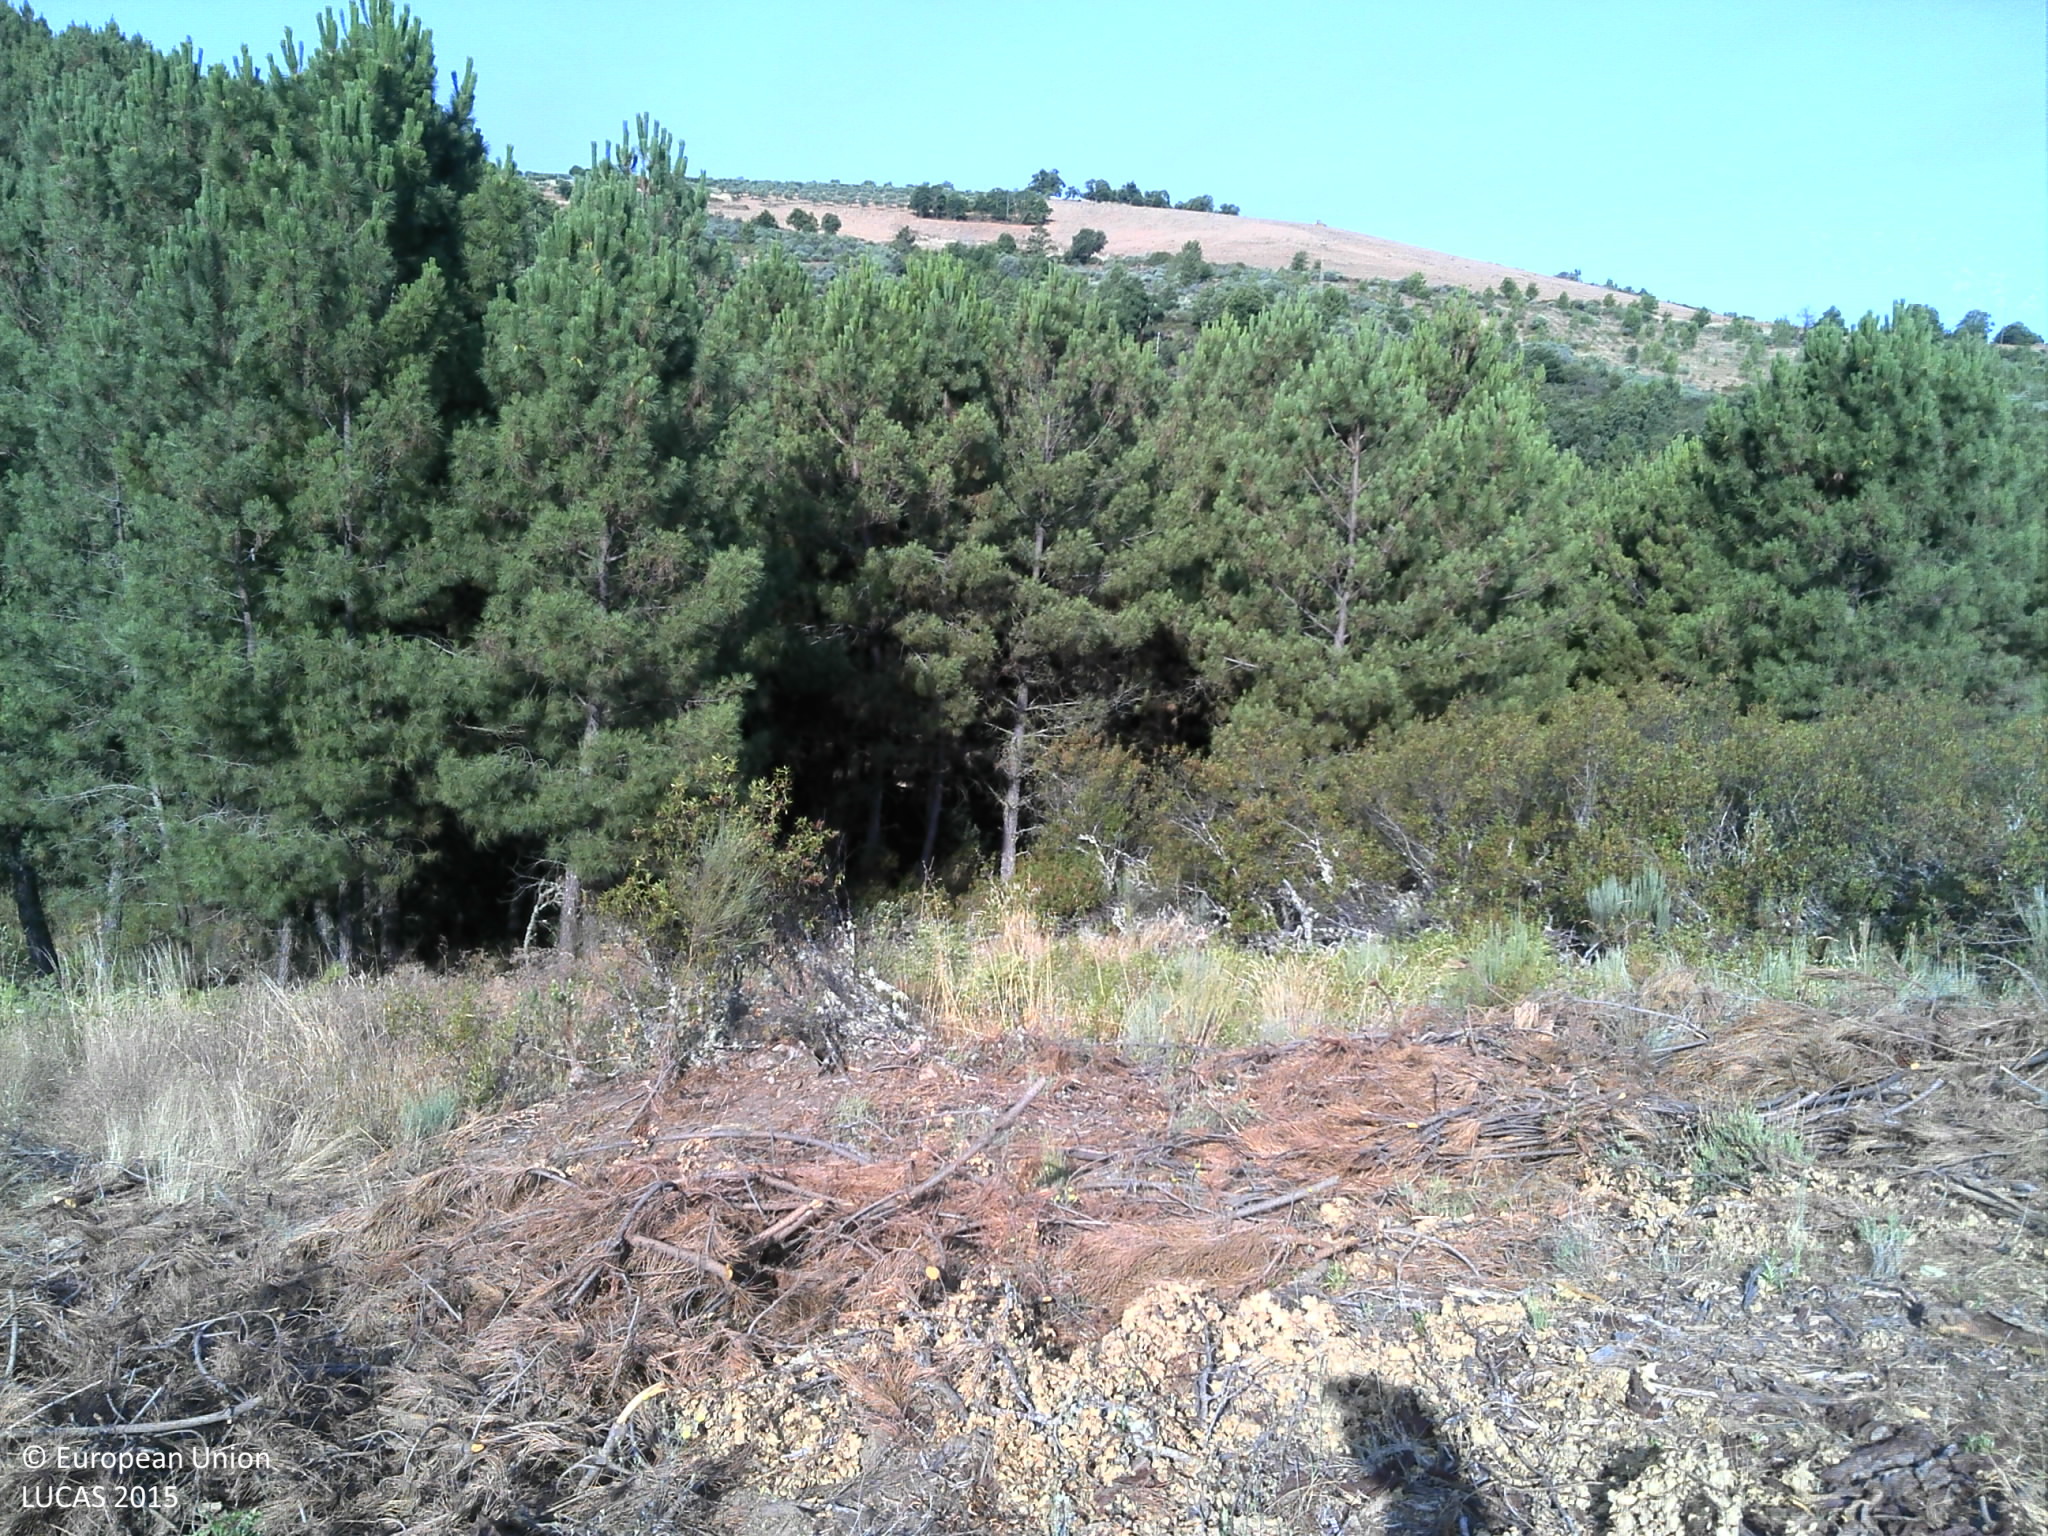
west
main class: Grassland
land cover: Spontaneously vegetated surfaces
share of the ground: > 75 %
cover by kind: herbaceous plants 90 %, unconsolidated bare surface 10 %
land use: Fallow land
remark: Clear cut
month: July
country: PT
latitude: 41.0324
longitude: -7.3508
